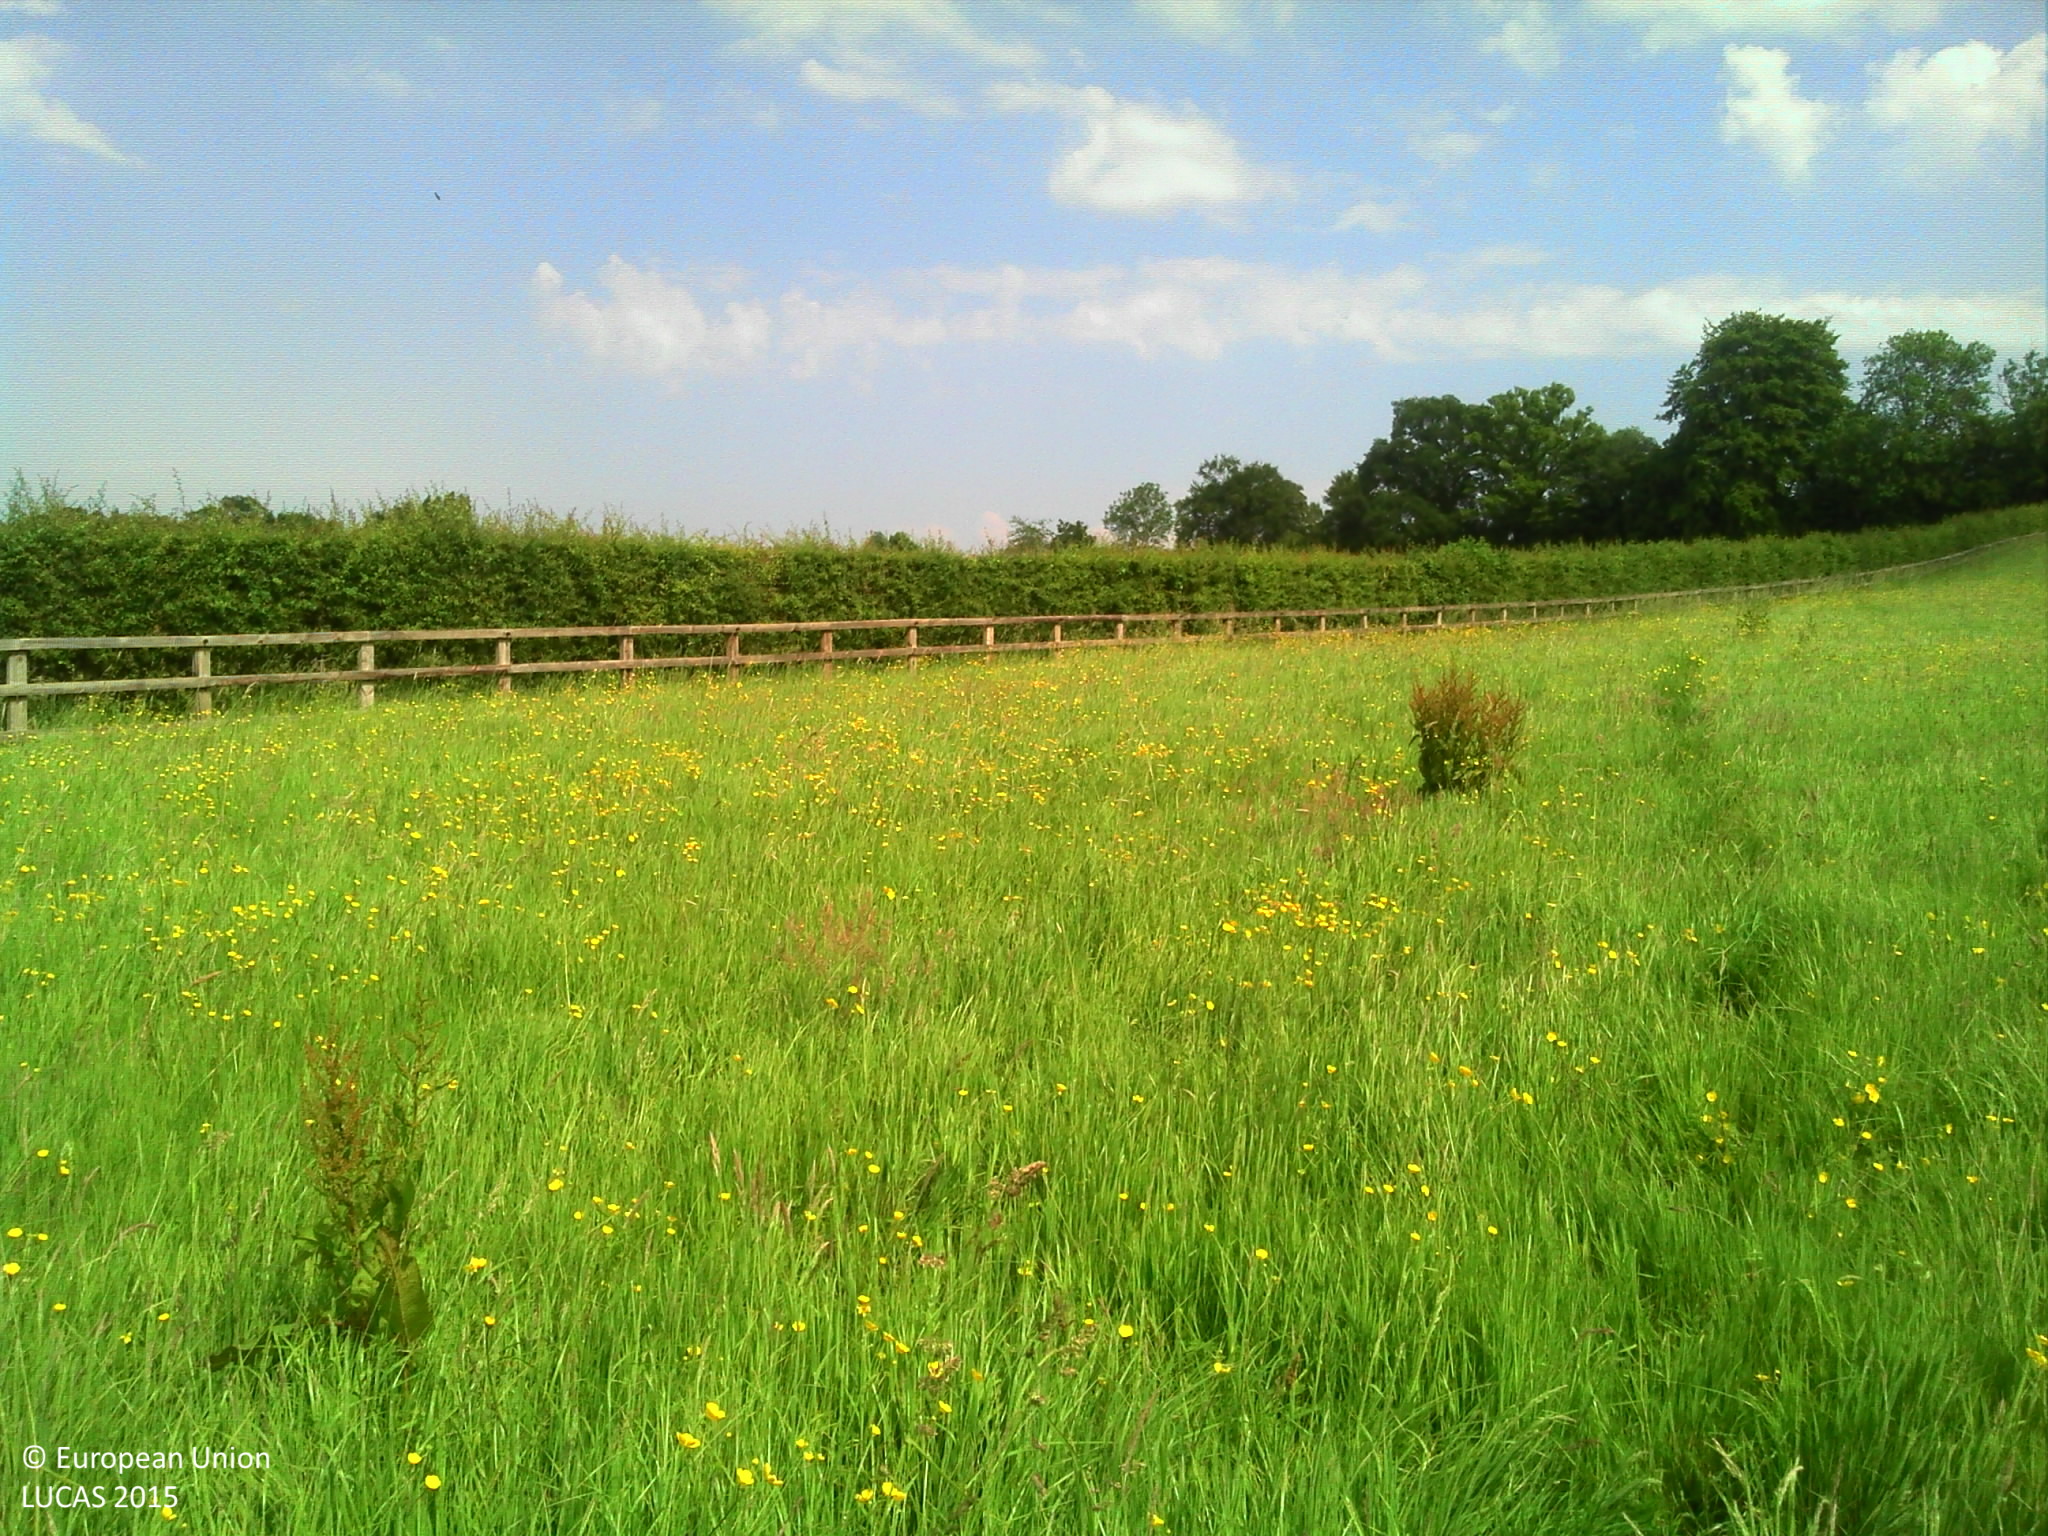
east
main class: Grassland
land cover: Grassland without tree/shrub cover
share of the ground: > 75 %
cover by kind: herbaceous plants 95 %
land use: Agriculture (excluding fallow land and kitchen gardens)
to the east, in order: Grassland without tree/shrub cover; Fences; Managed hedges; Fences; Grassland without tree/shrub cover; Managed hedges
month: June
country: FR
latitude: 48.7257
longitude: 0.1701
